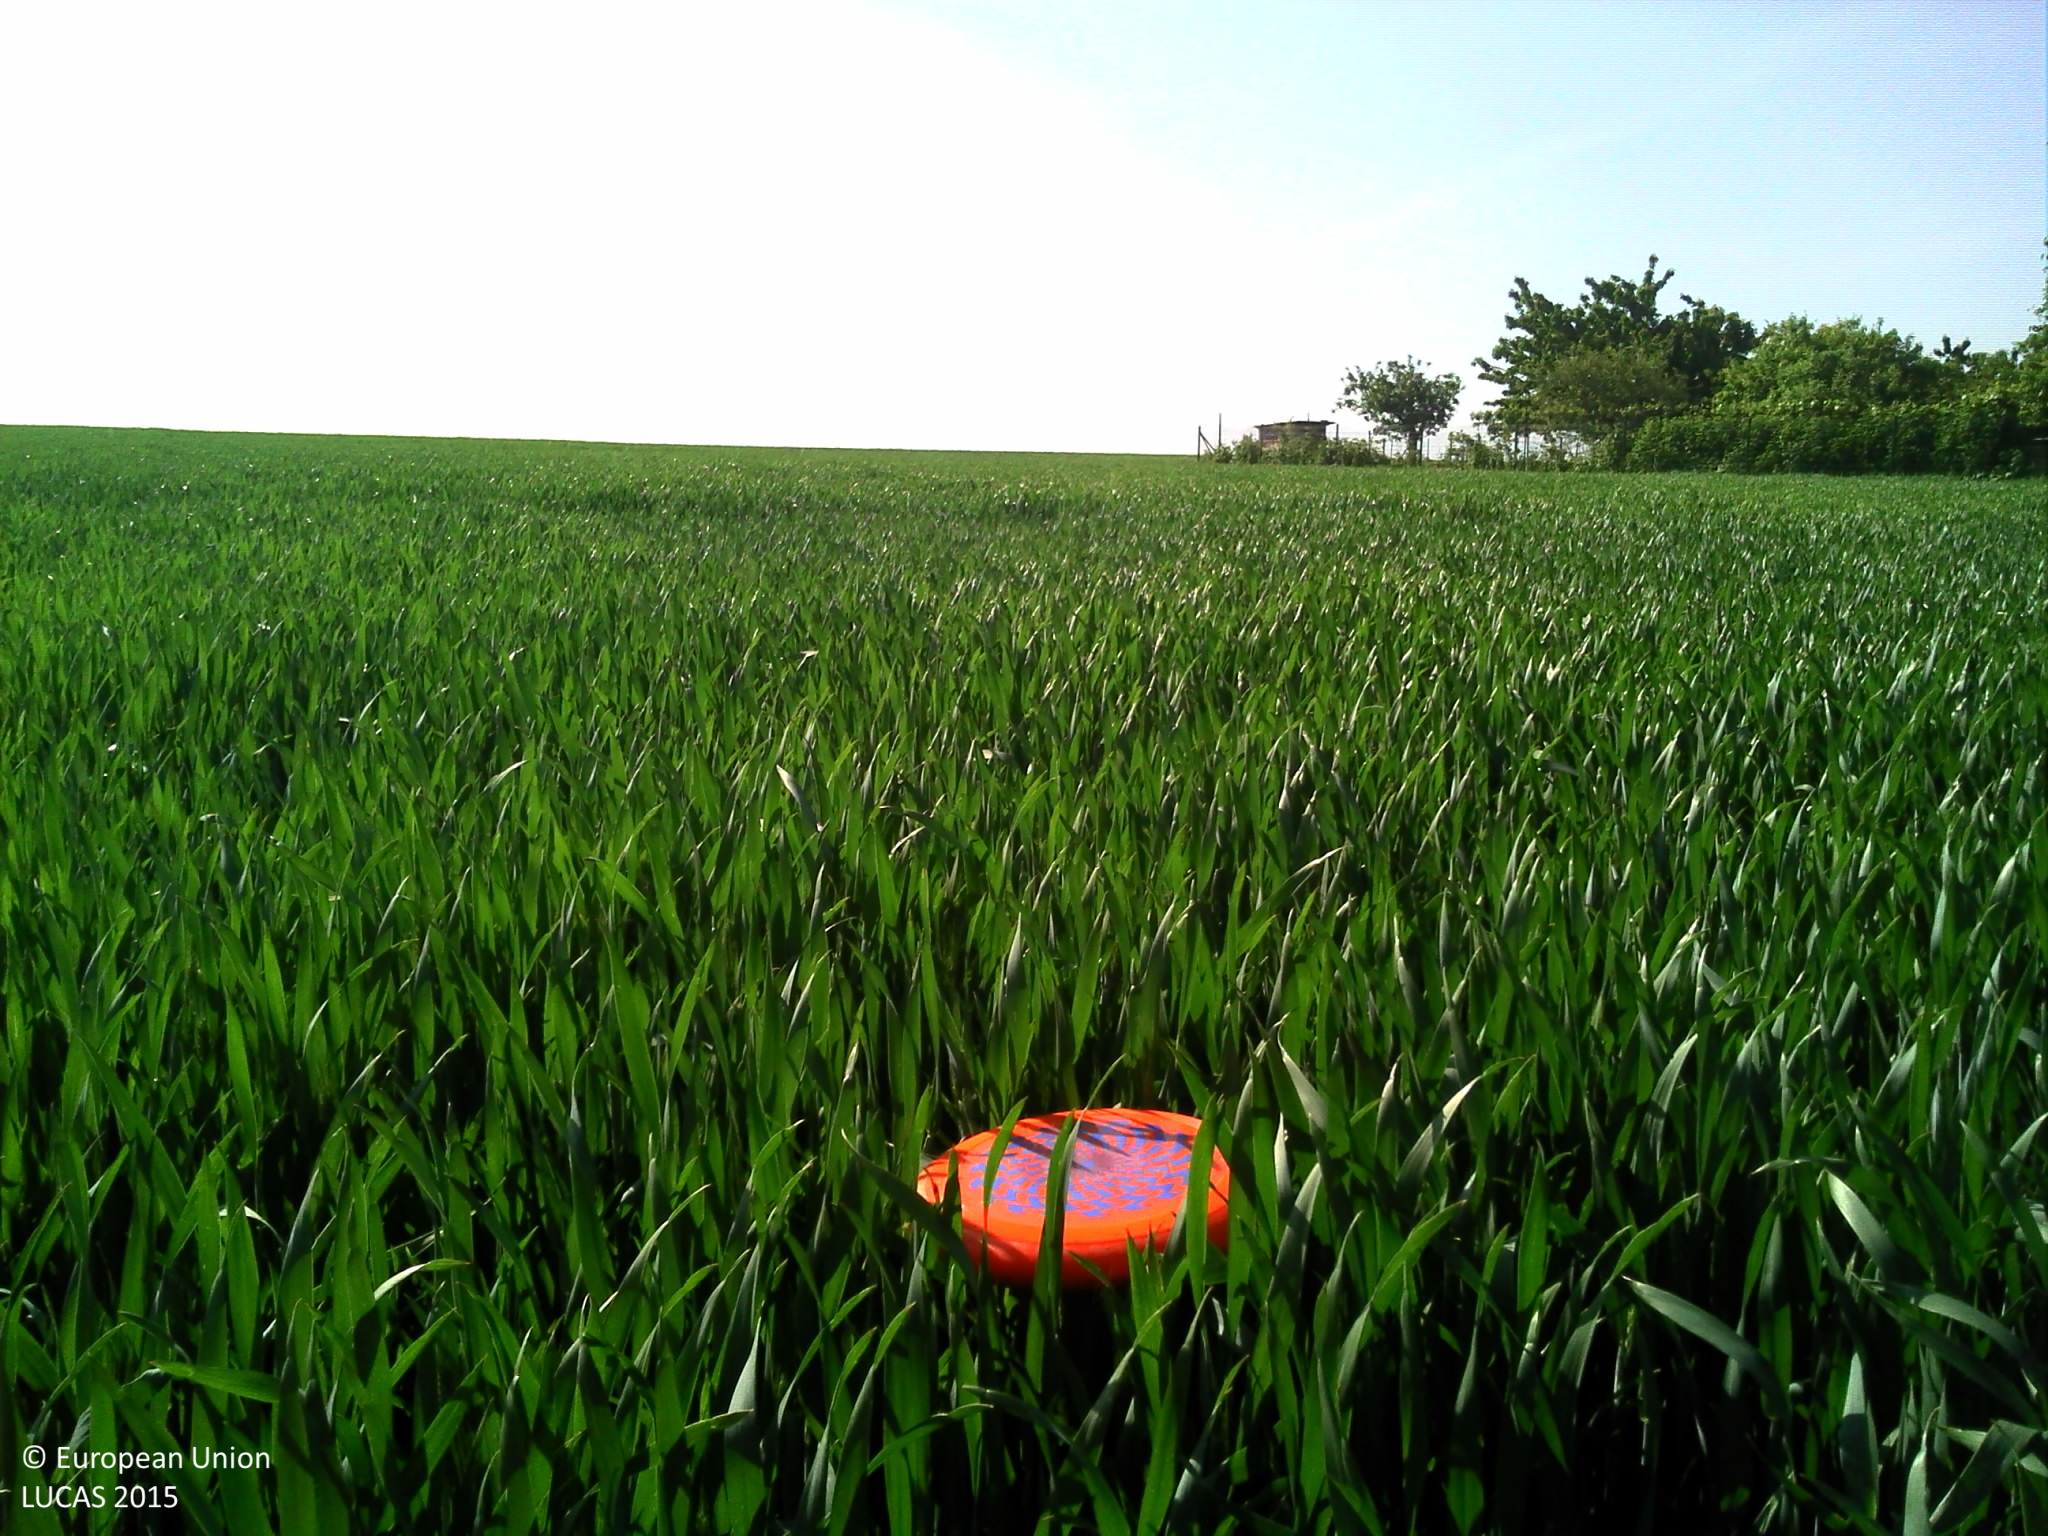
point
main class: Cropland
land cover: Common wheat
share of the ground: > 75 %
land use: Agriculture (excluding fallow land and kitchen gardens)
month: May
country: BE
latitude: 50.6812
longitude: 5.2849
